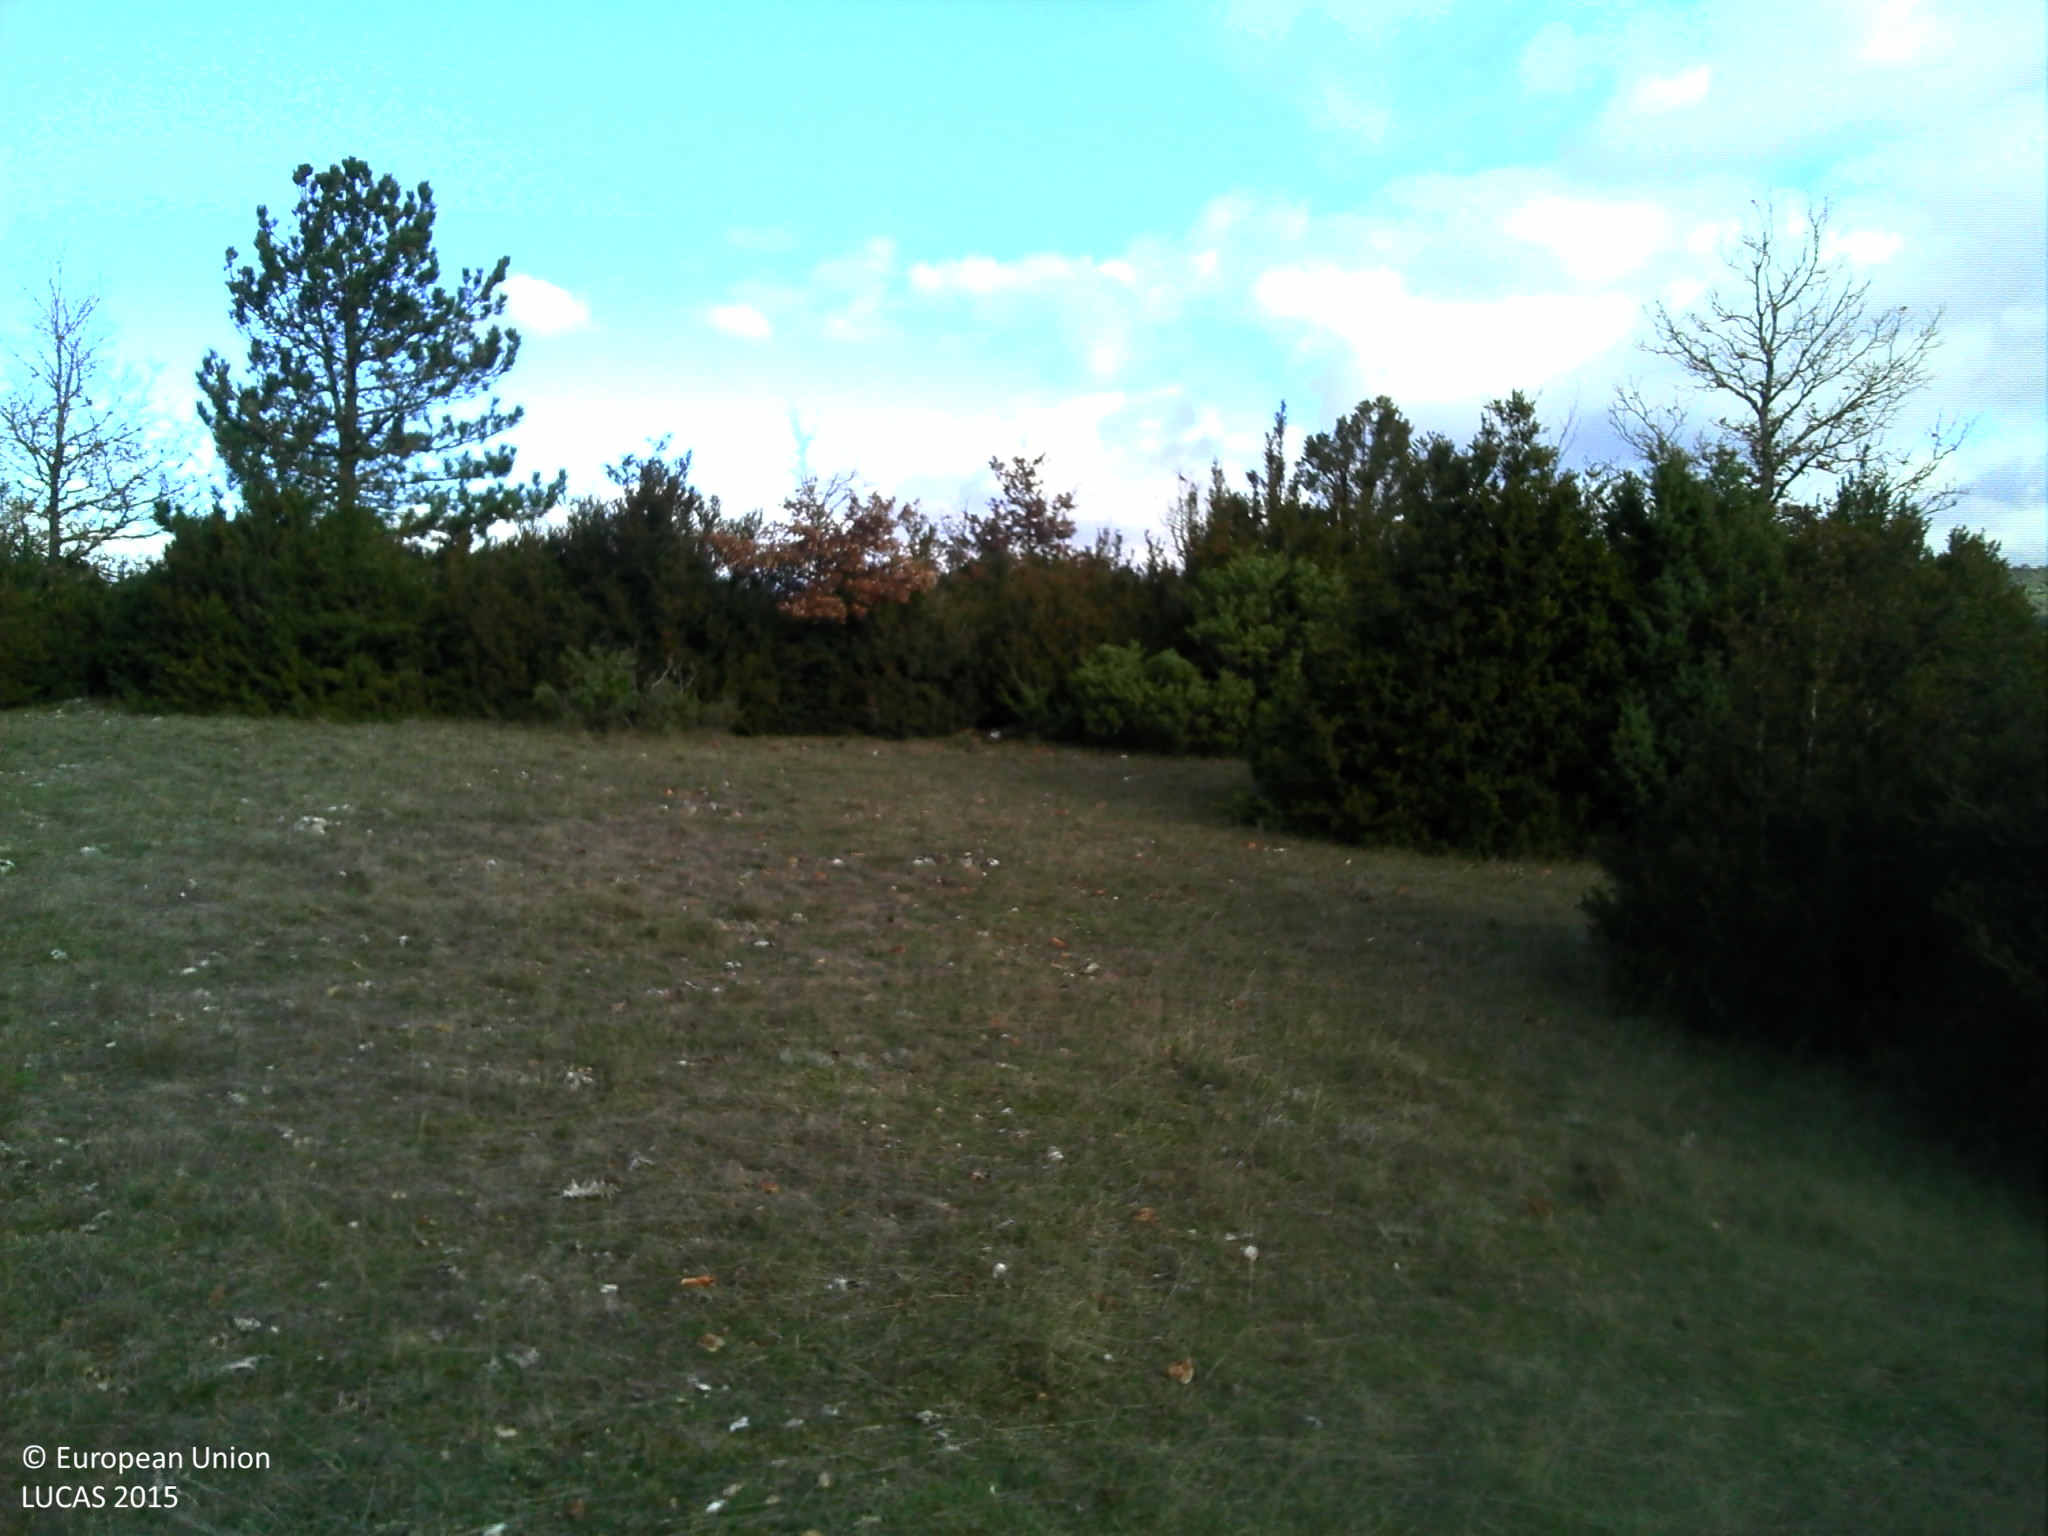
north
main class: Grassland
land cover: Grassland with sparse tree/shrub cover
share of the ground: > 75 %
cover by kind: herbaceous plants 90 %, coniferous forest trees 5 %, shrubs 5 %
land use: Agriculture (excluding fallow land and kitchen gardens)
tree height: < 5 m
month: November
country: FR
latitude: 43.9148
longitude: 3.2700
